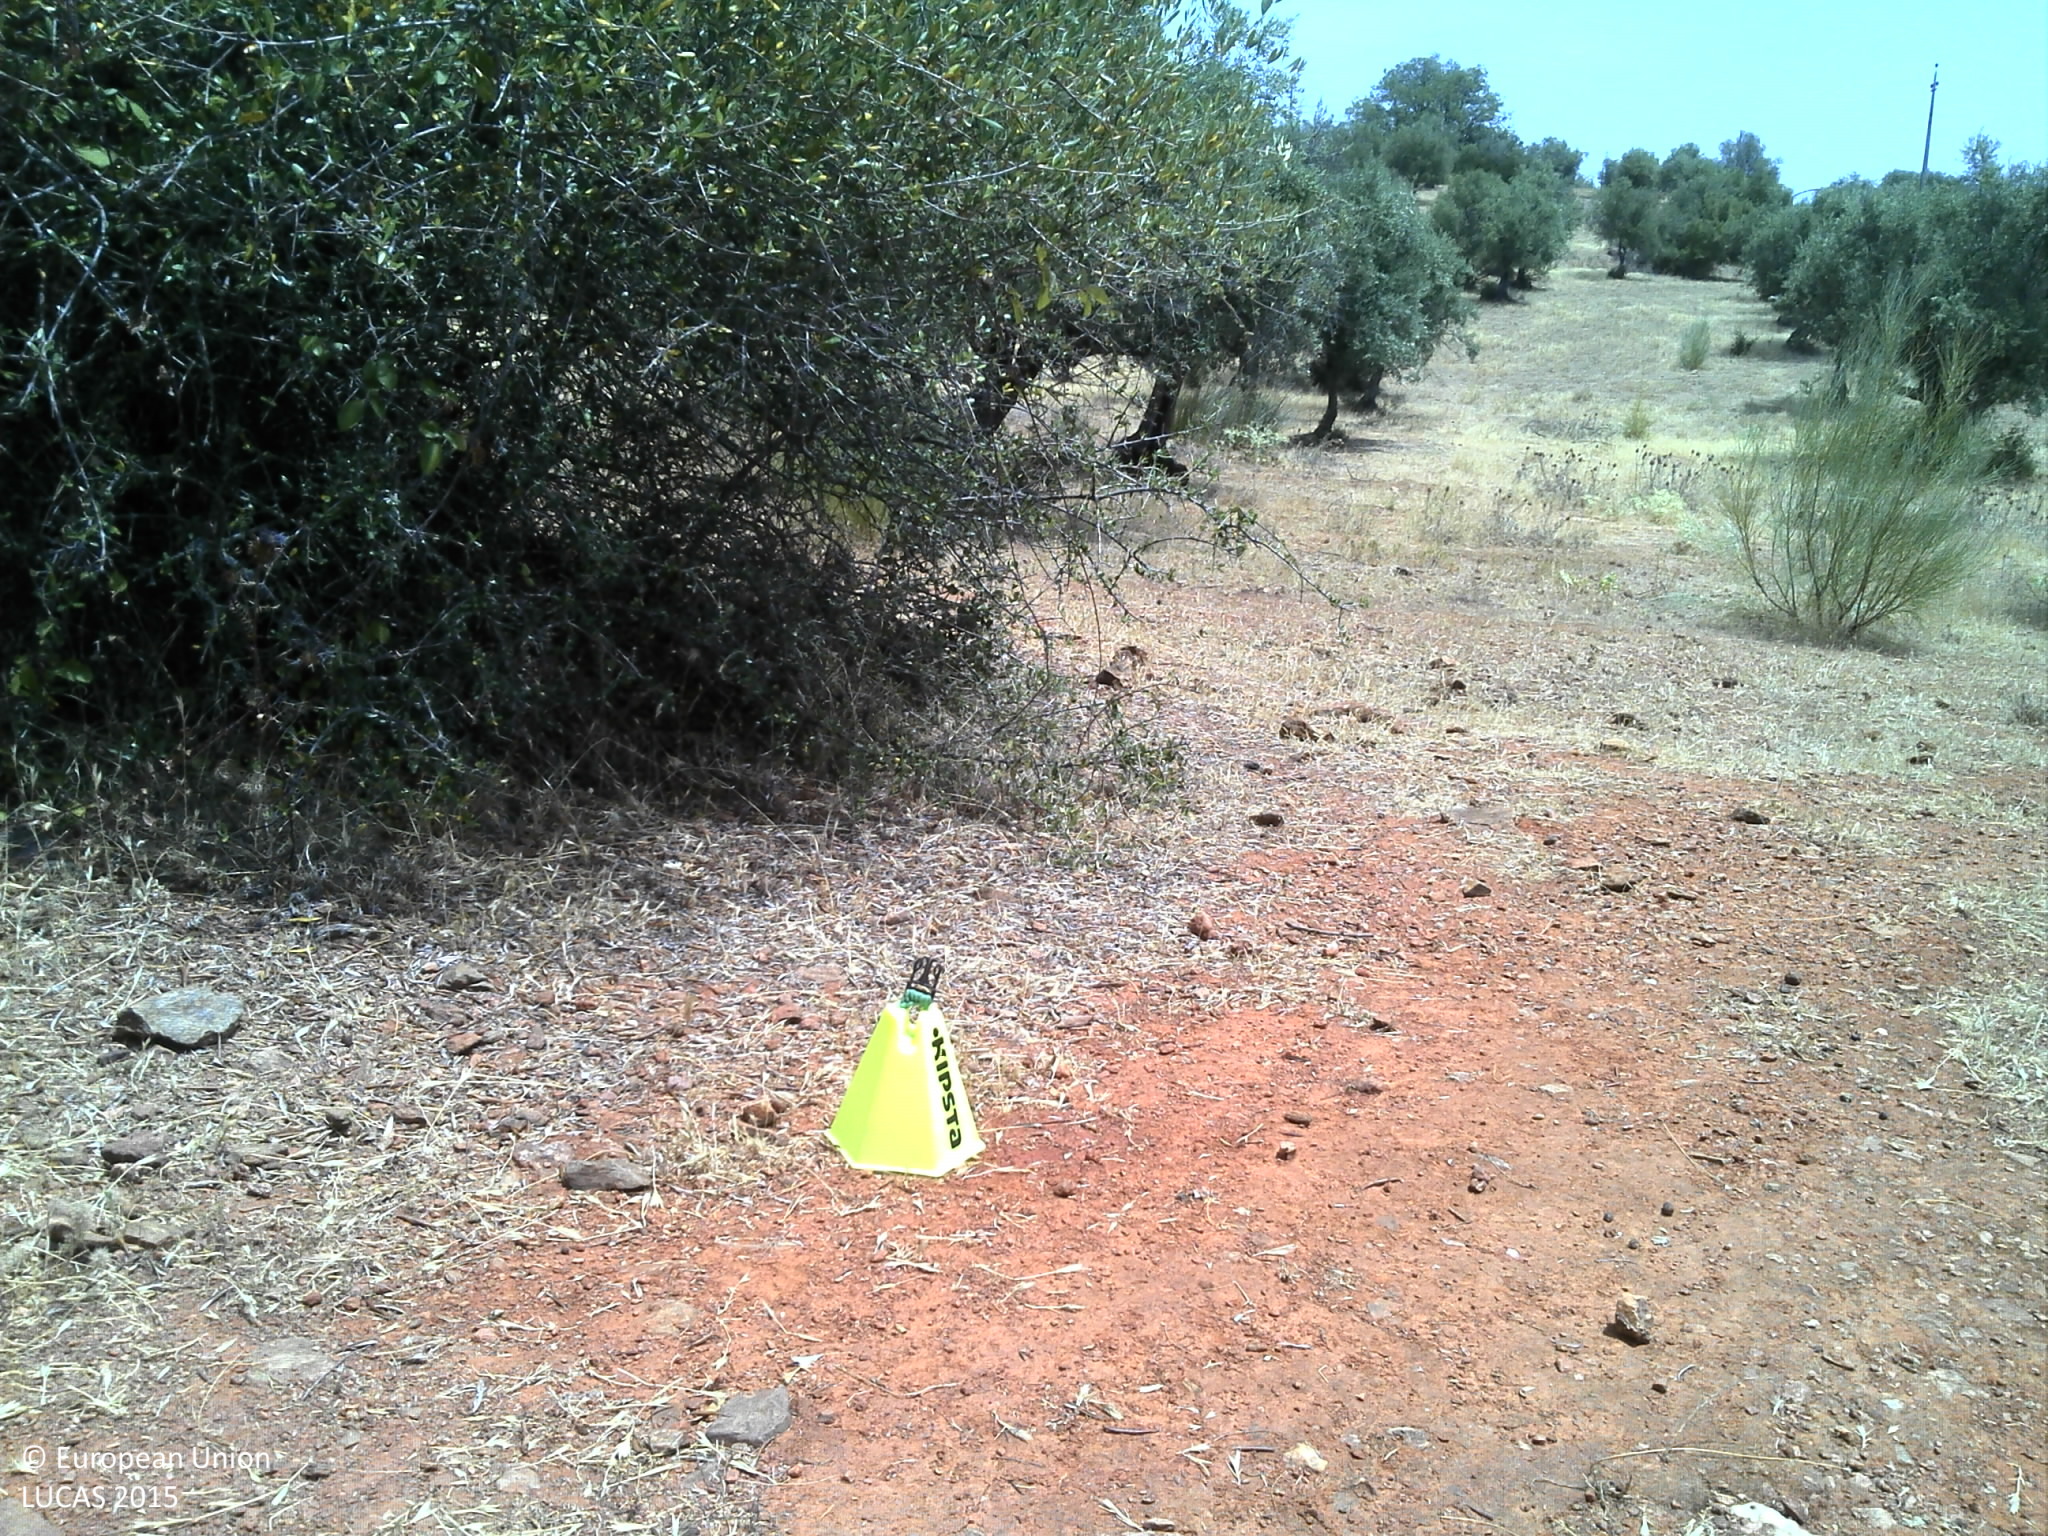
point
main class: Cropland
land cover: Olive groves
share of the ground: 25 - 50 %
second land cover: Grassland without tree/shrub cover
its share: 25 - 50 %
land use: Agriculture (excluding fallow land and kitchen gardens)
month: July
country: PT
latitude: 38.2231
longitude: -7.6754
